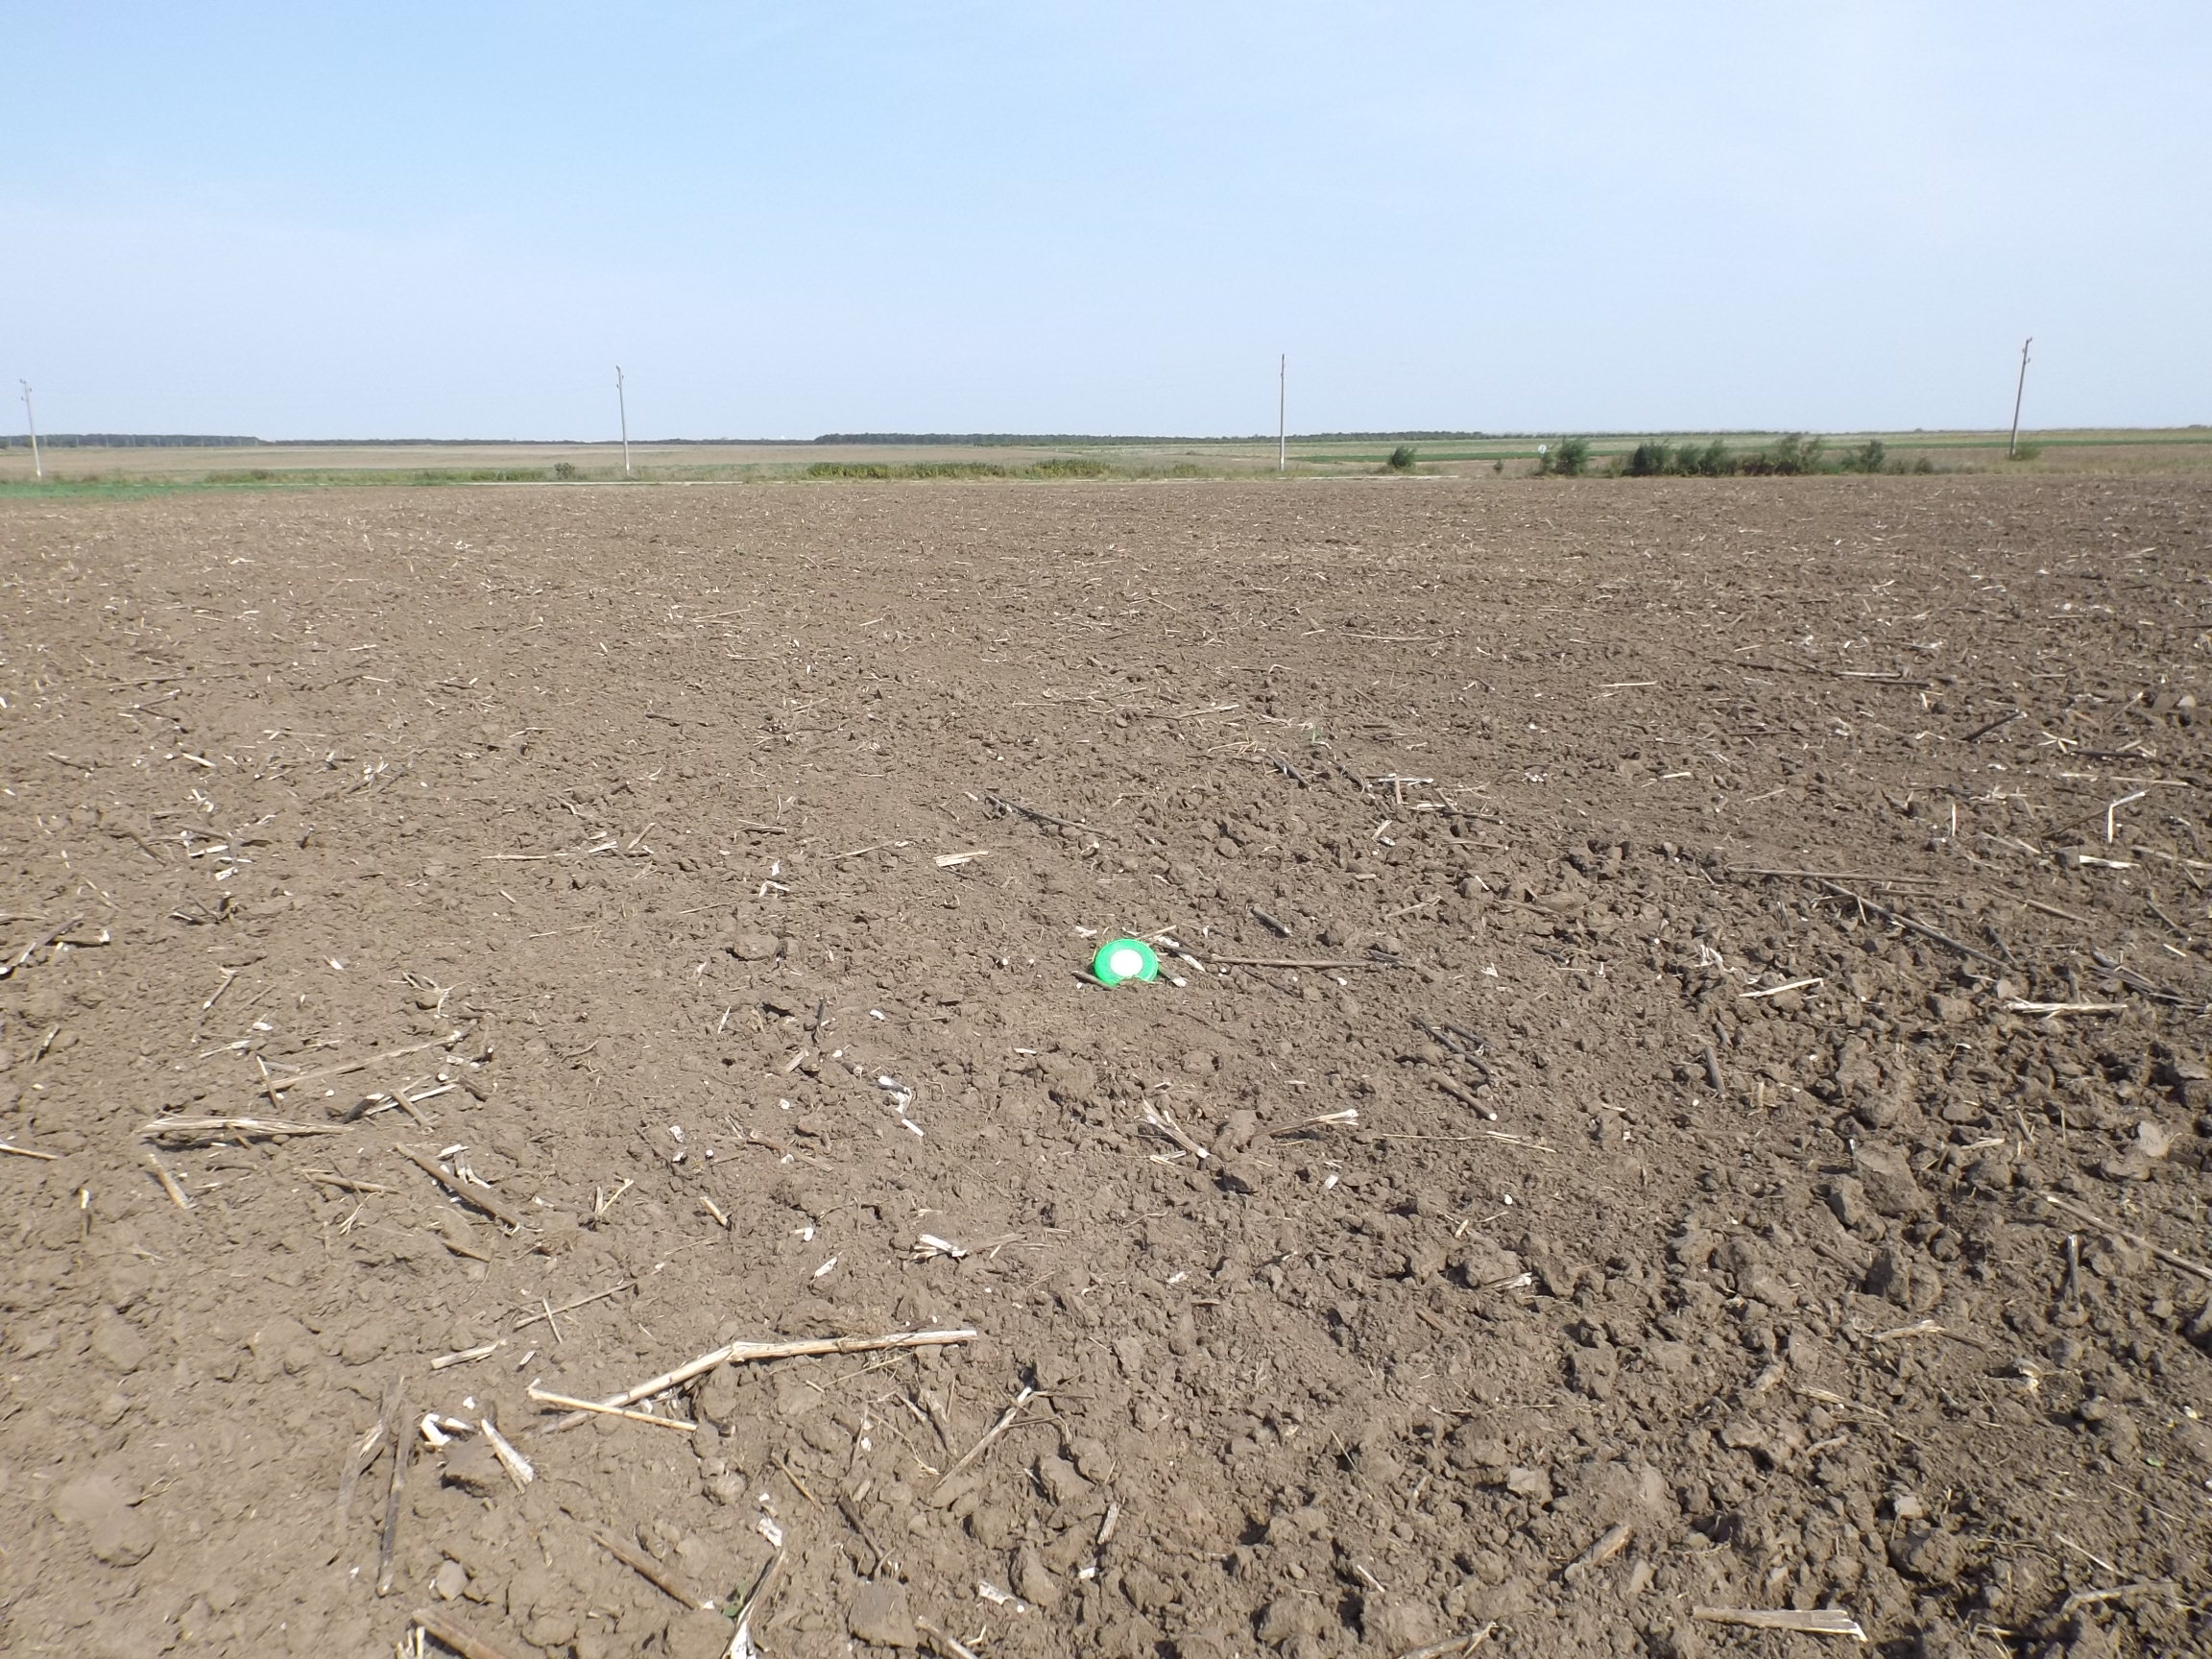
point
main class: Cropland
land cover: Sunflower
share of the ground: < 10 %
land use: Agriculture (excluding fallow land and kitchen gardens)
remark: Harvested field
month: September
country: BG
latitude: 43.9922
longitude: 26.8402
